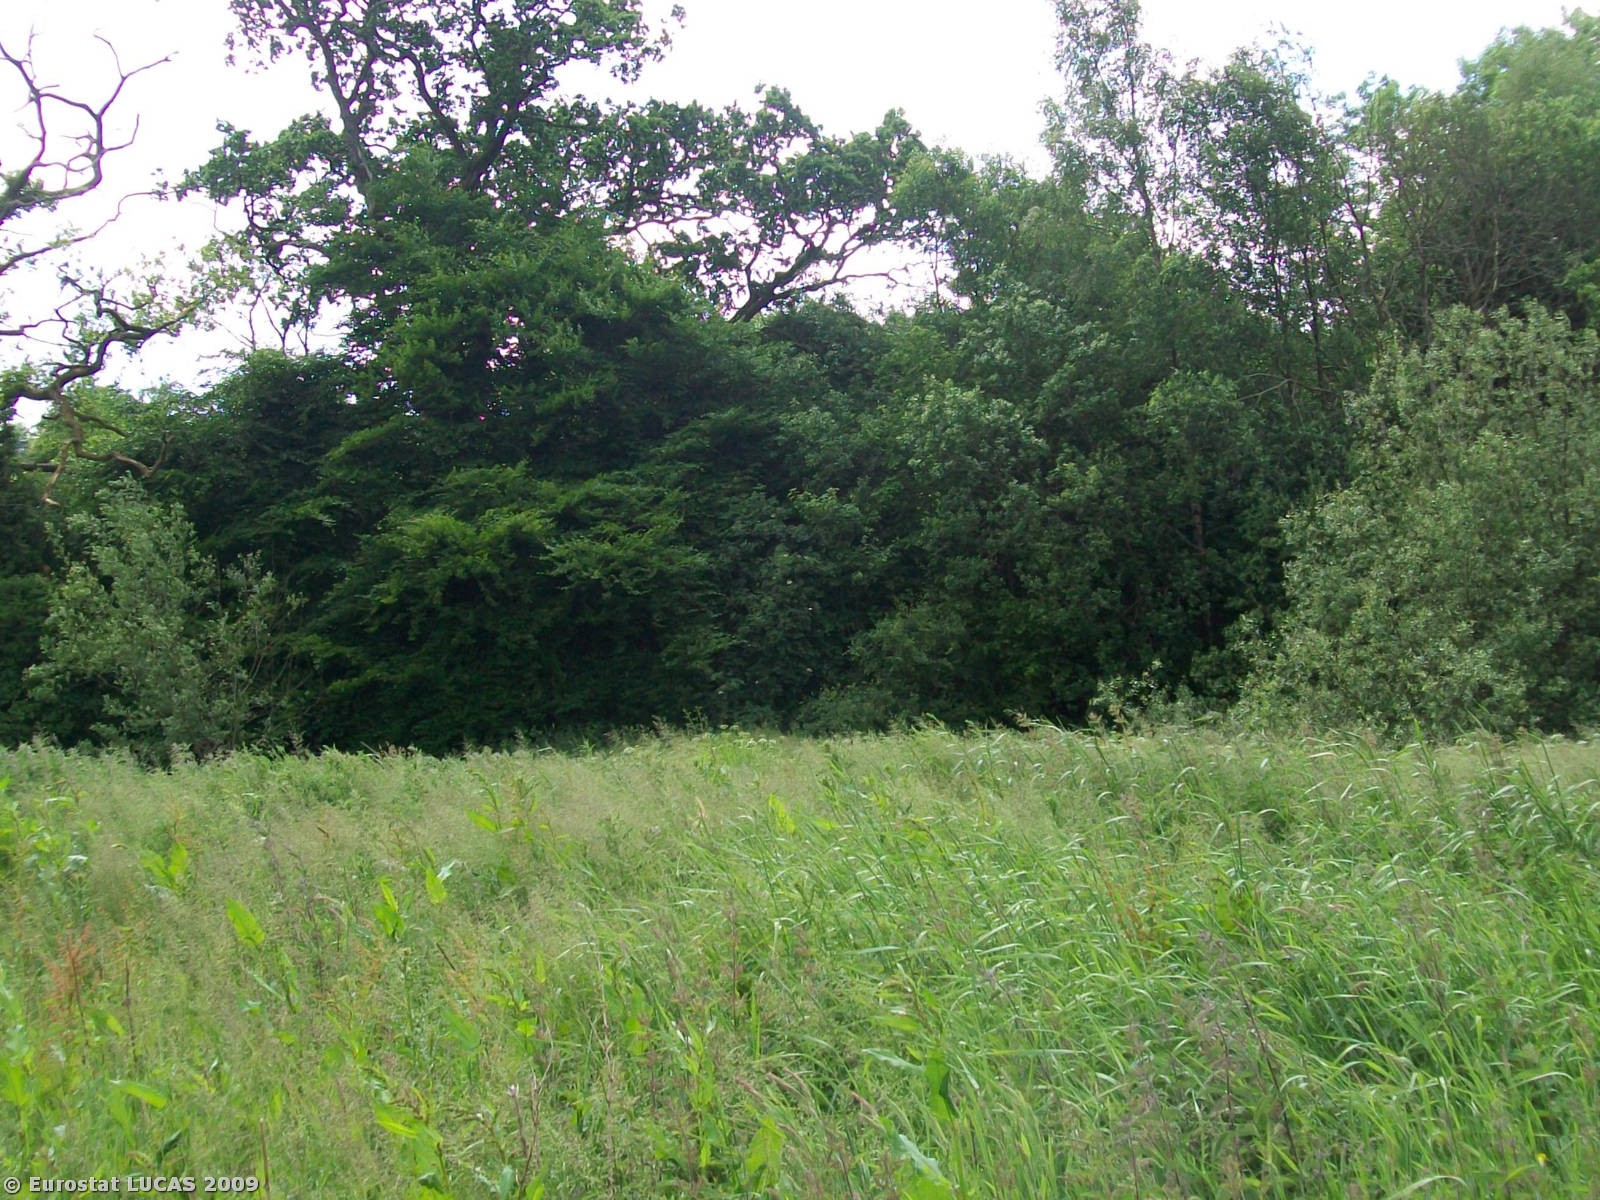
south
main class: Grassland
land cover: Grassland without tree/shrub cover
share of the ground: > 75 %
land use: Agriculture (excluding fallow land and kitchen gardens)
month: June
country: GB
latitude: 51.0104
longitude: -3.4089
